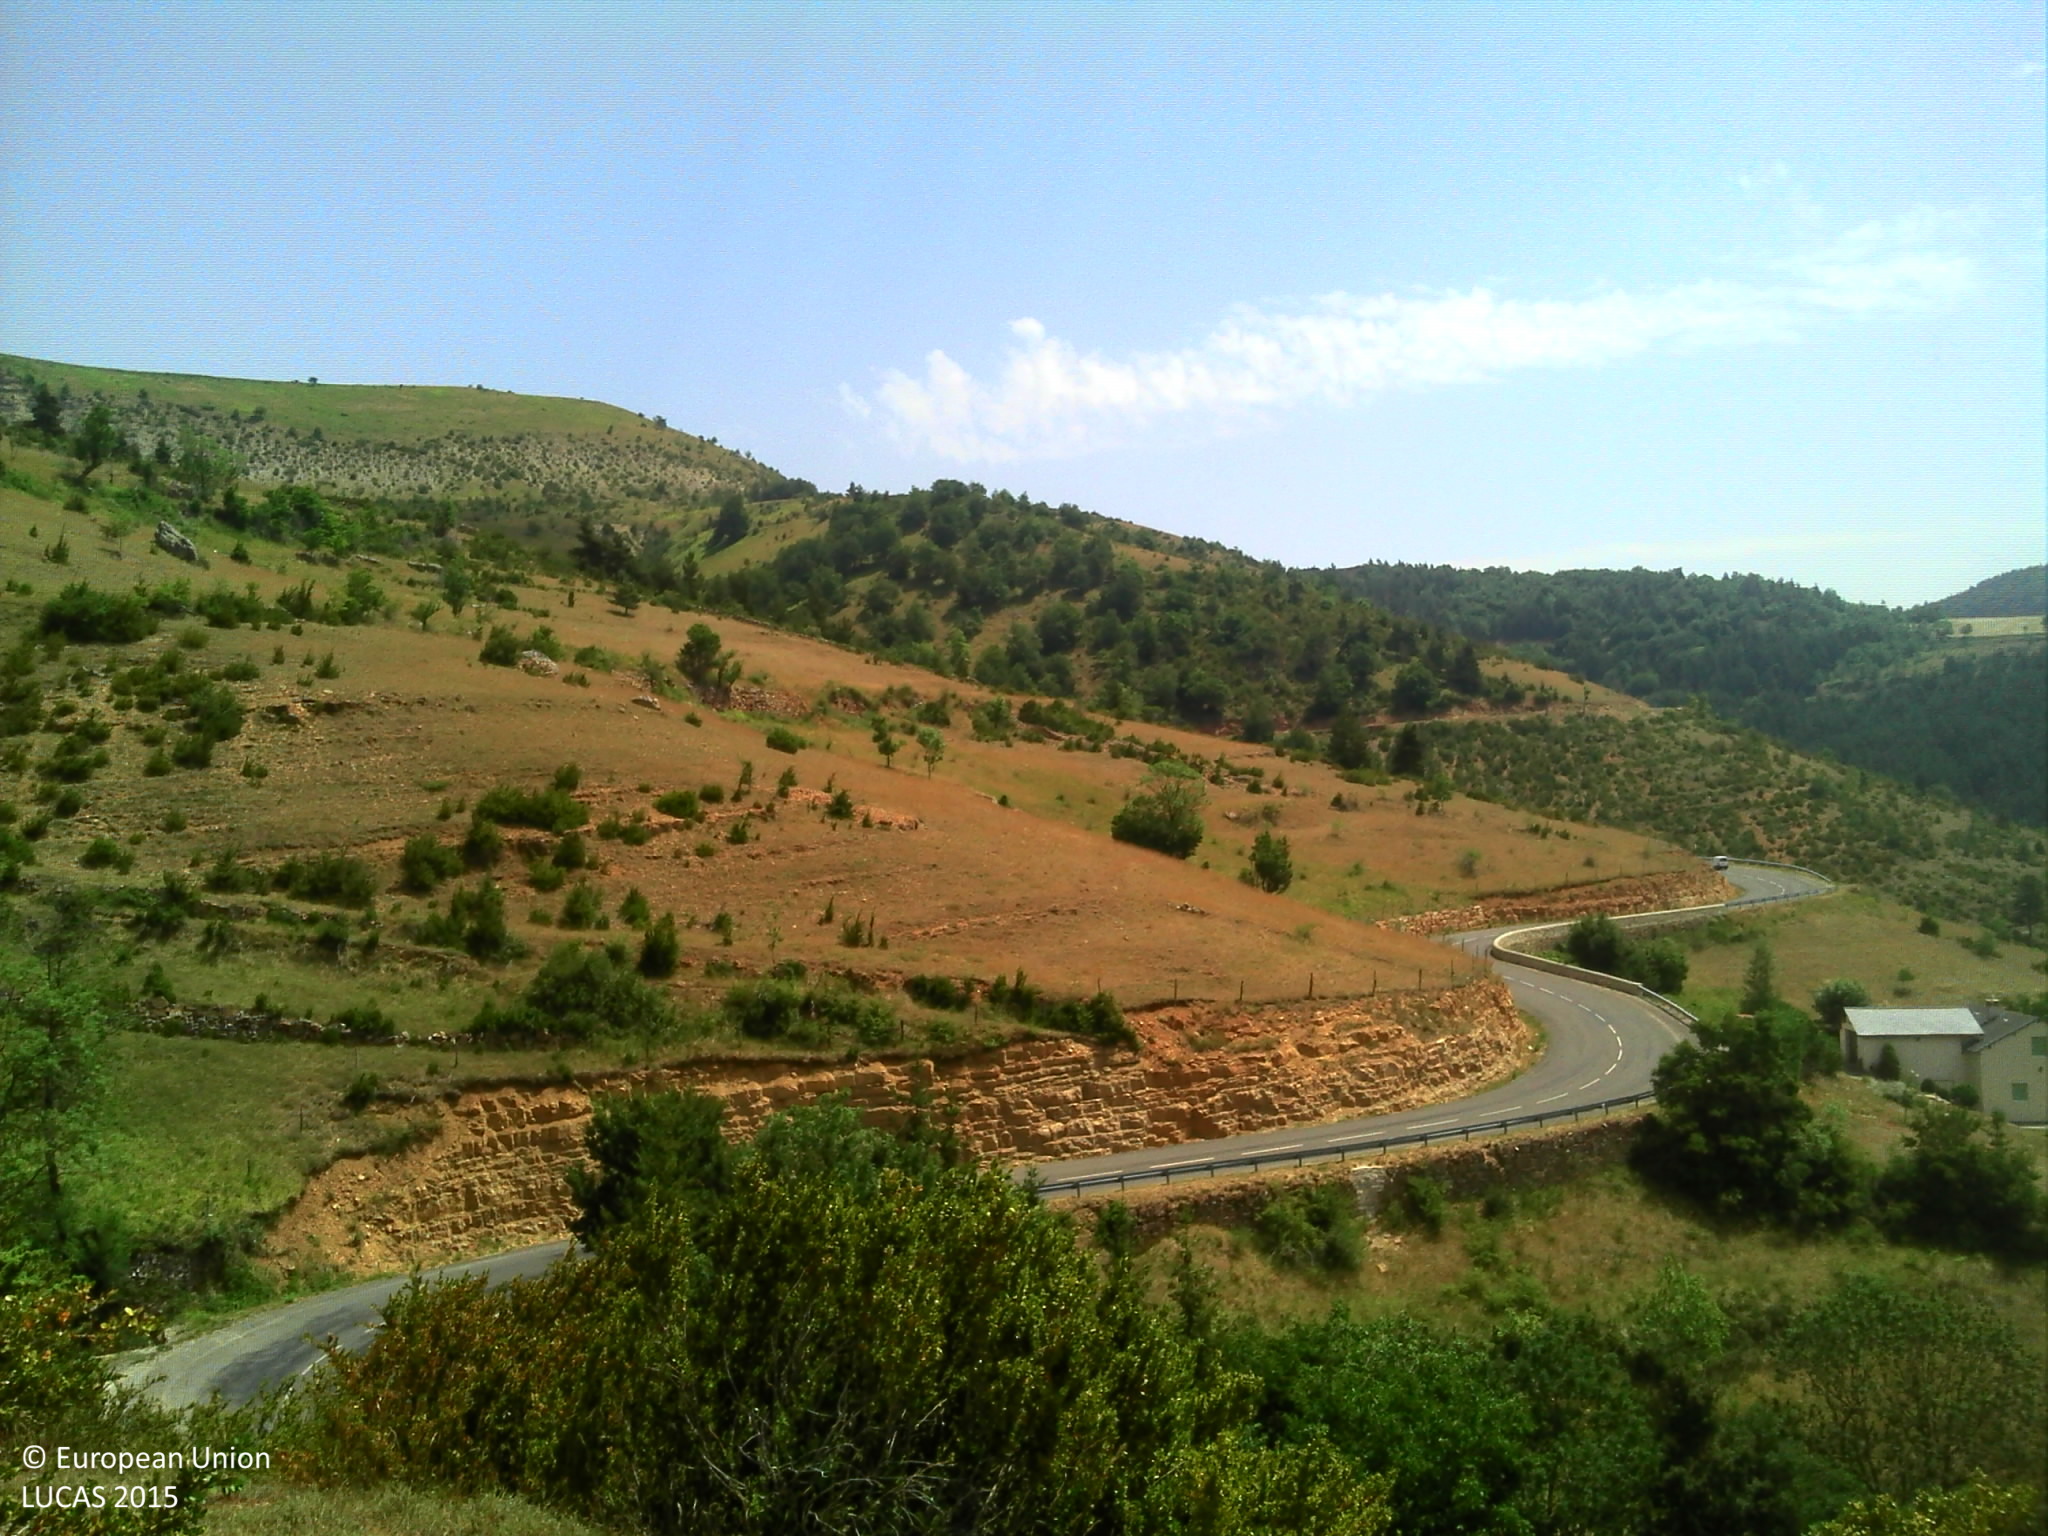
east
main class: Shrubland
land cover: Shrubland without tree cover
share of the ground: > 75 %
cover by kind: herbaceous plants 55 %, shrubs 45 %
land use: Agriculture (excluding fallow land and kitchen gardens)
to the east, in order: Shrubland without tree cover; Sand; Paved roads, cycling and walking lanes; Broadleaved woodland; Rivers and streams; Broadleaved woodland; Tracks; Broadleaved woodland; Fences; Paved roads, cycling and walking lanes; Ditches and canals; Rocks and stones; Fences; Shrubland without tree cover; Rocks and stones; Grassland without tree/shrub cover; Dry stone walls
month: July
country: FR
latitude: 44.2002
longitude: 3.4871
